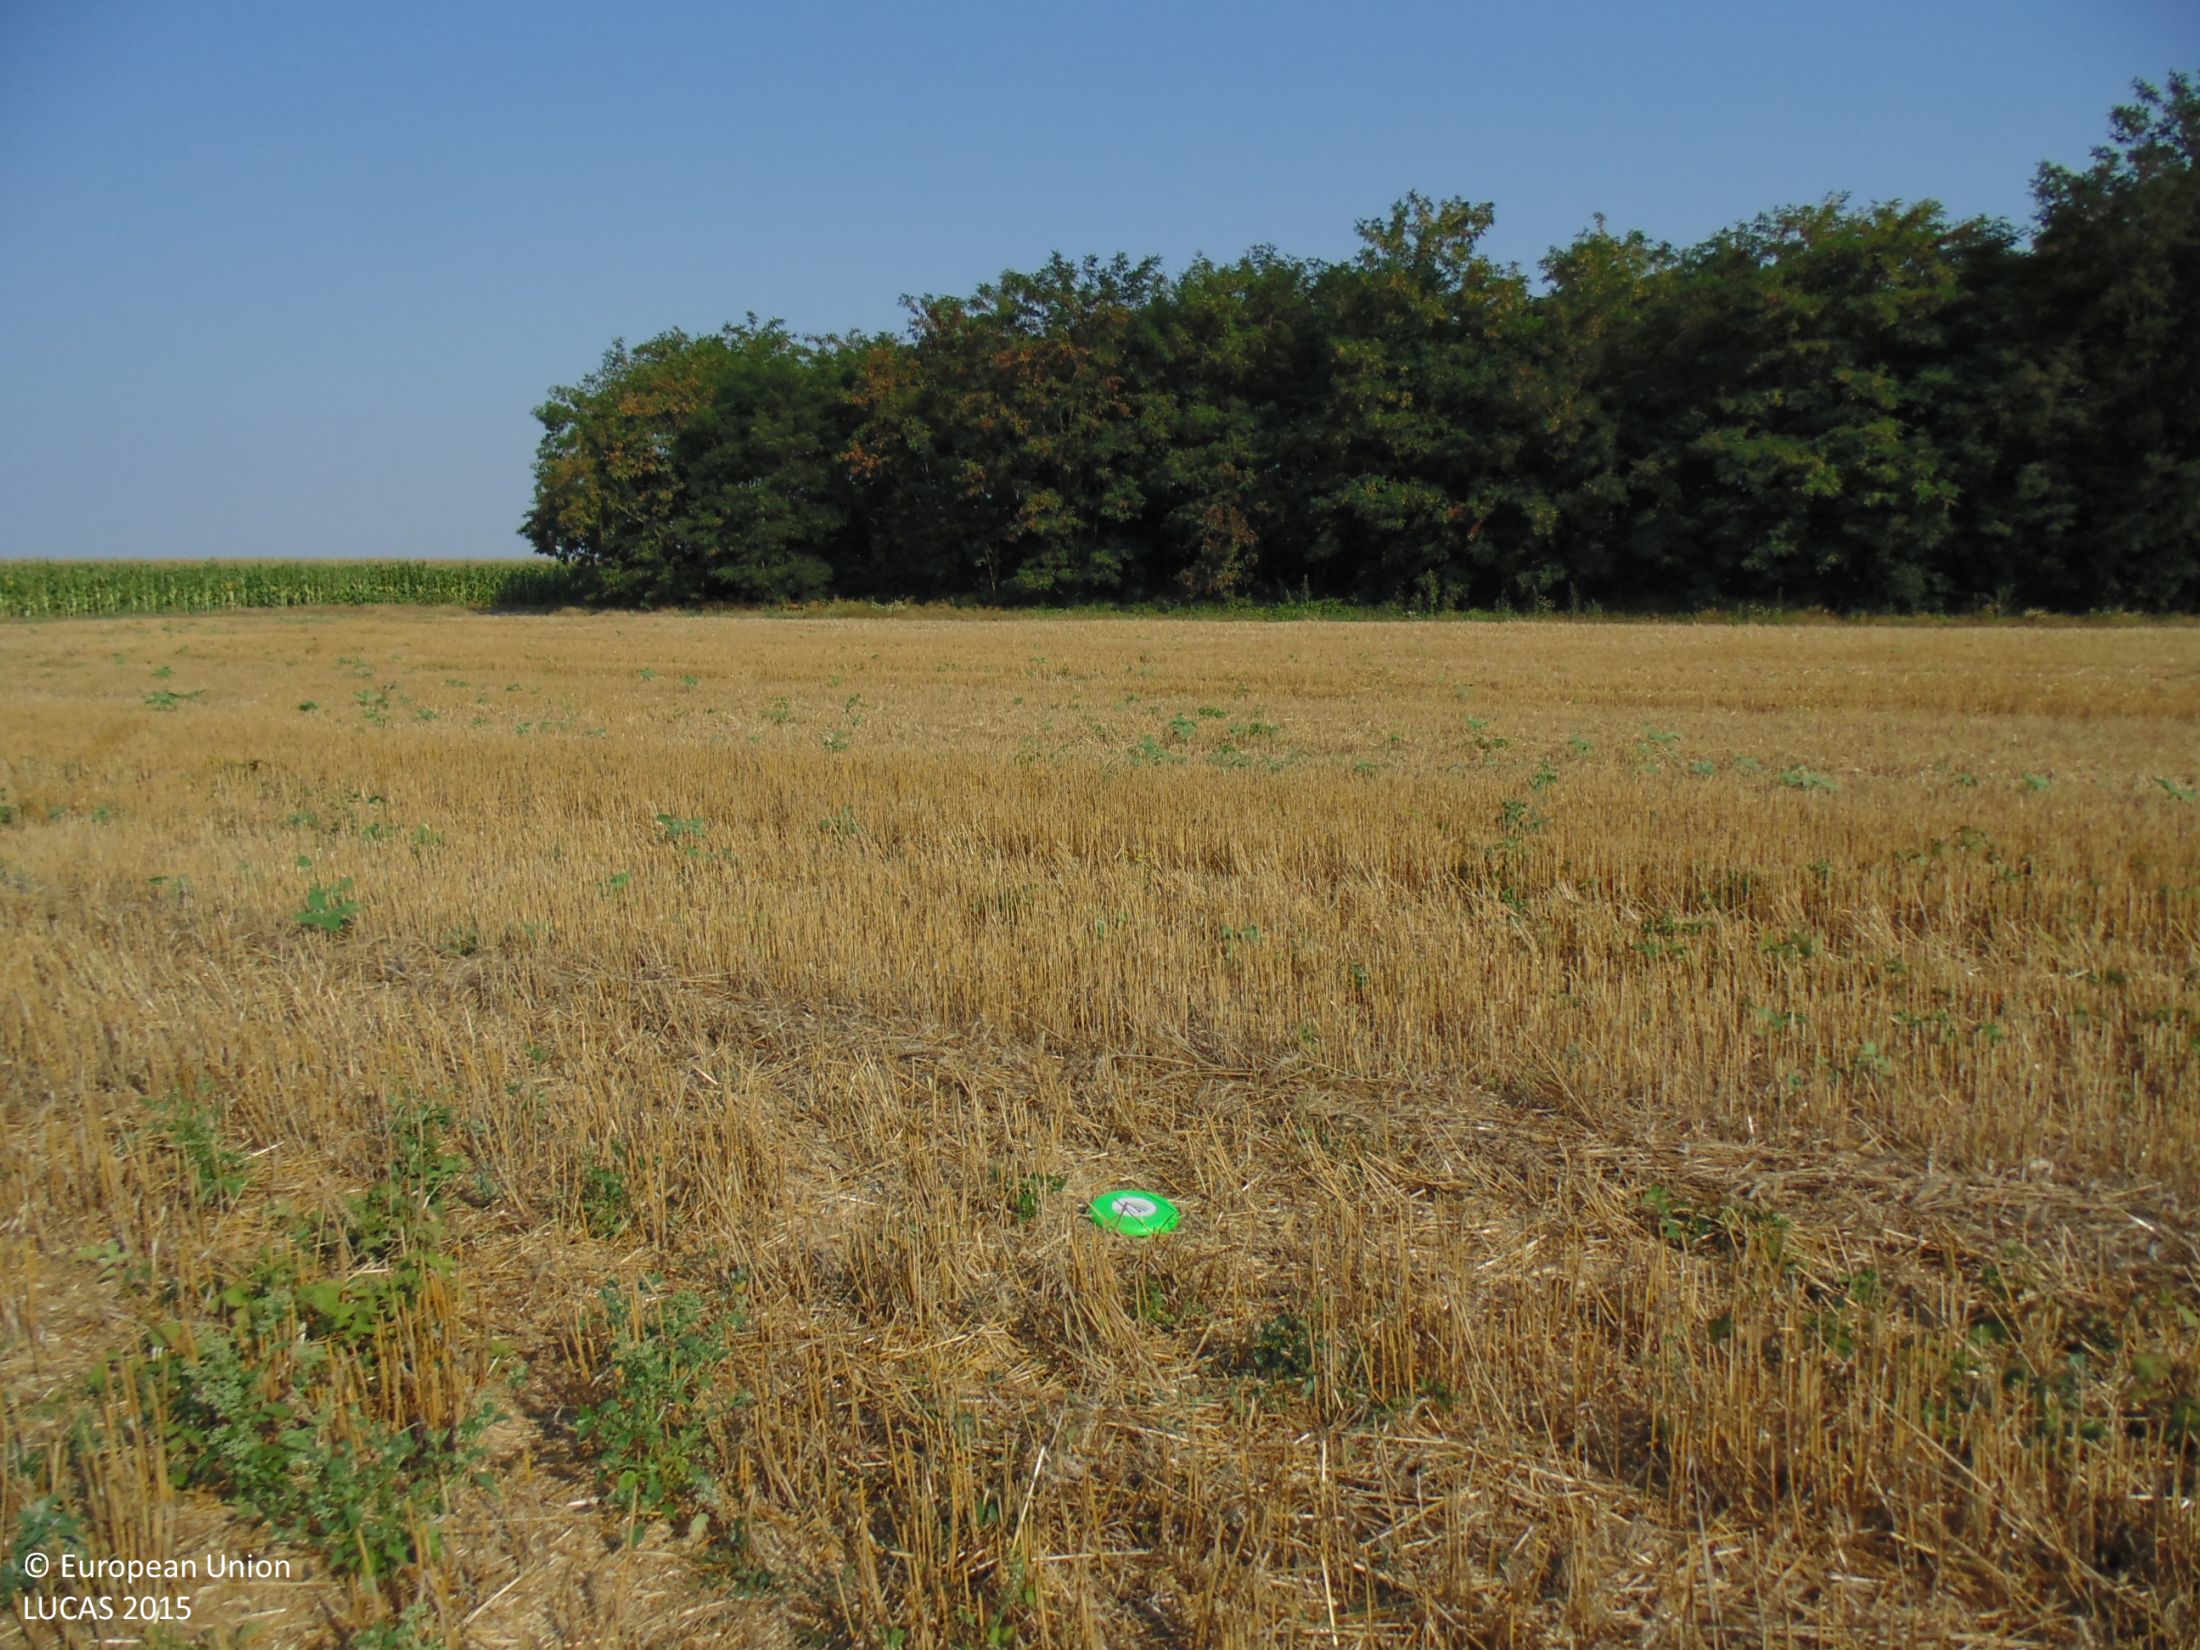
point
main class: Cropland
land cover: Common wheat
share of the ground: 25 - 50 %
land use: Agriculture (excluding fallow land and kitchen gardens)
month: July
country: BG
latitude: 43.5740
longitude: 27.9896
